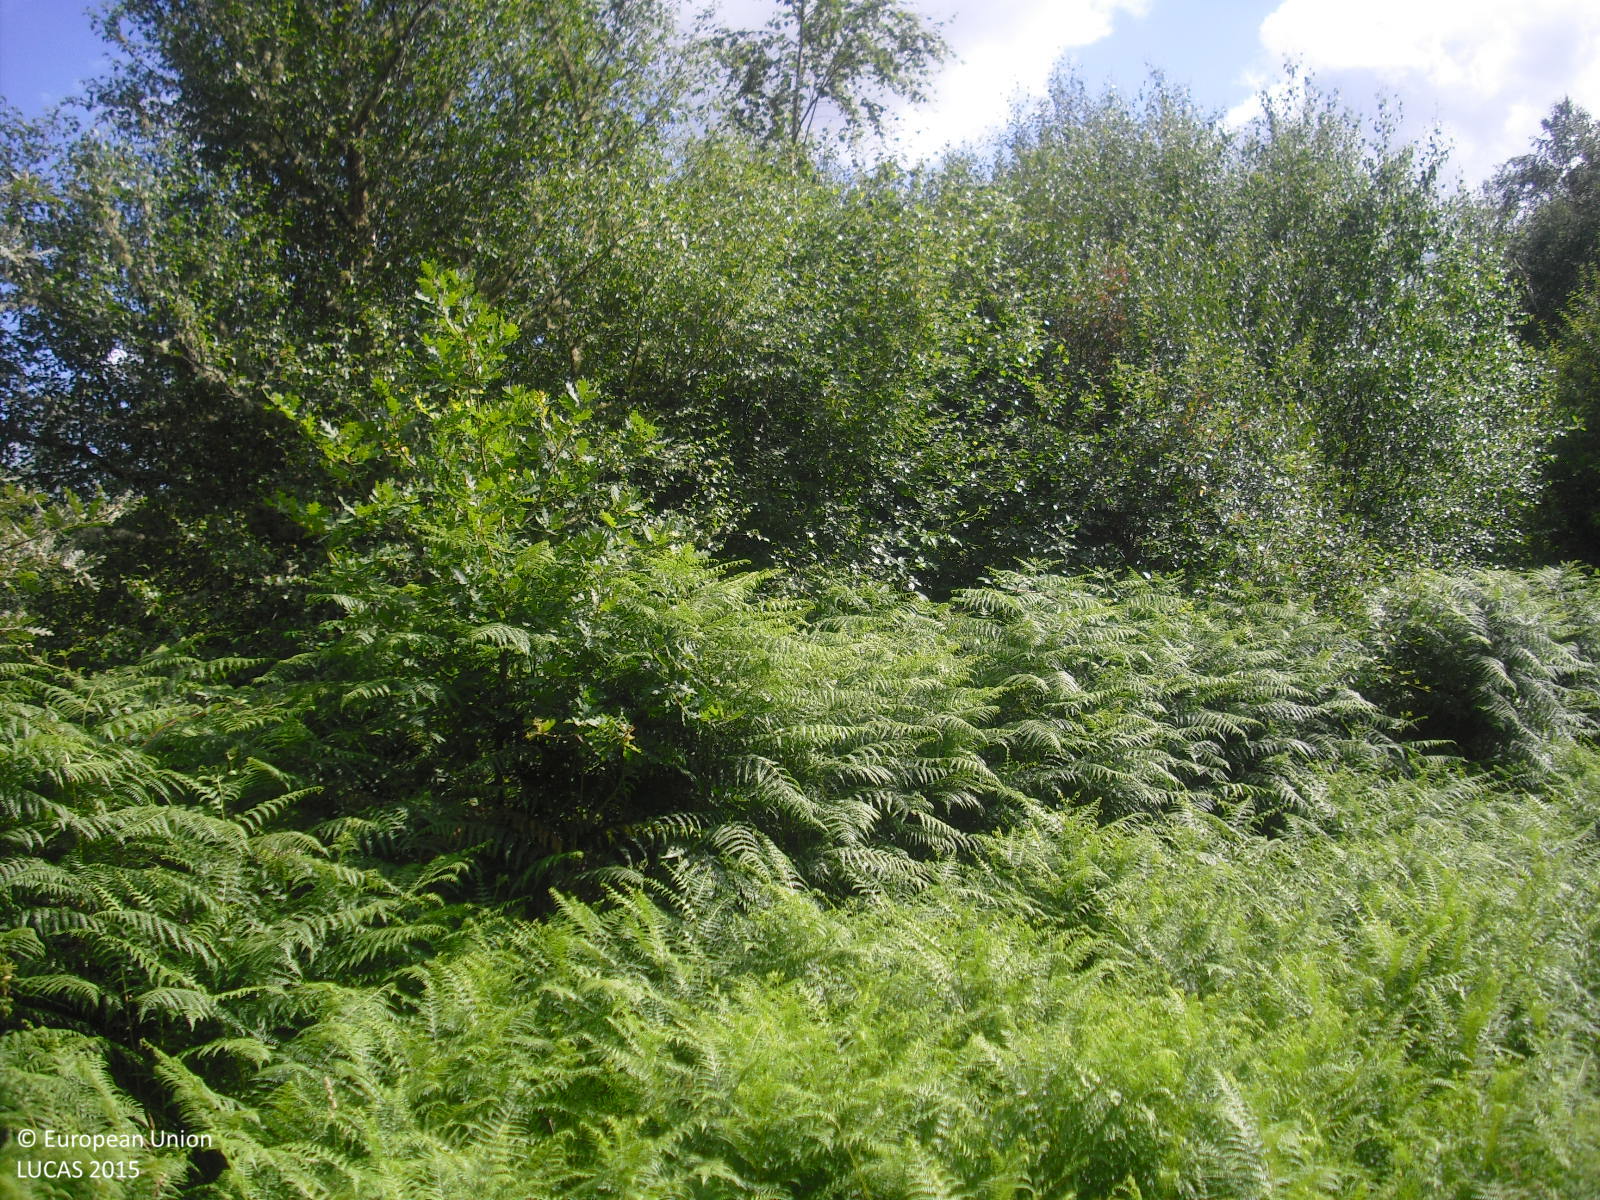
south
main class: Woodland
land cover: Broadleaved woodland
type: thermophilous deciduous forest
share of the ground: 50 - 75 %
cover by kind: broadleaved forest trees 60 %, shrubs 30 %, herbaceous plants 10 %
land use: Forestry
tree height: > 5 m
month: July
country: ES
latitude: 42.3376
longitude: -7.6830
